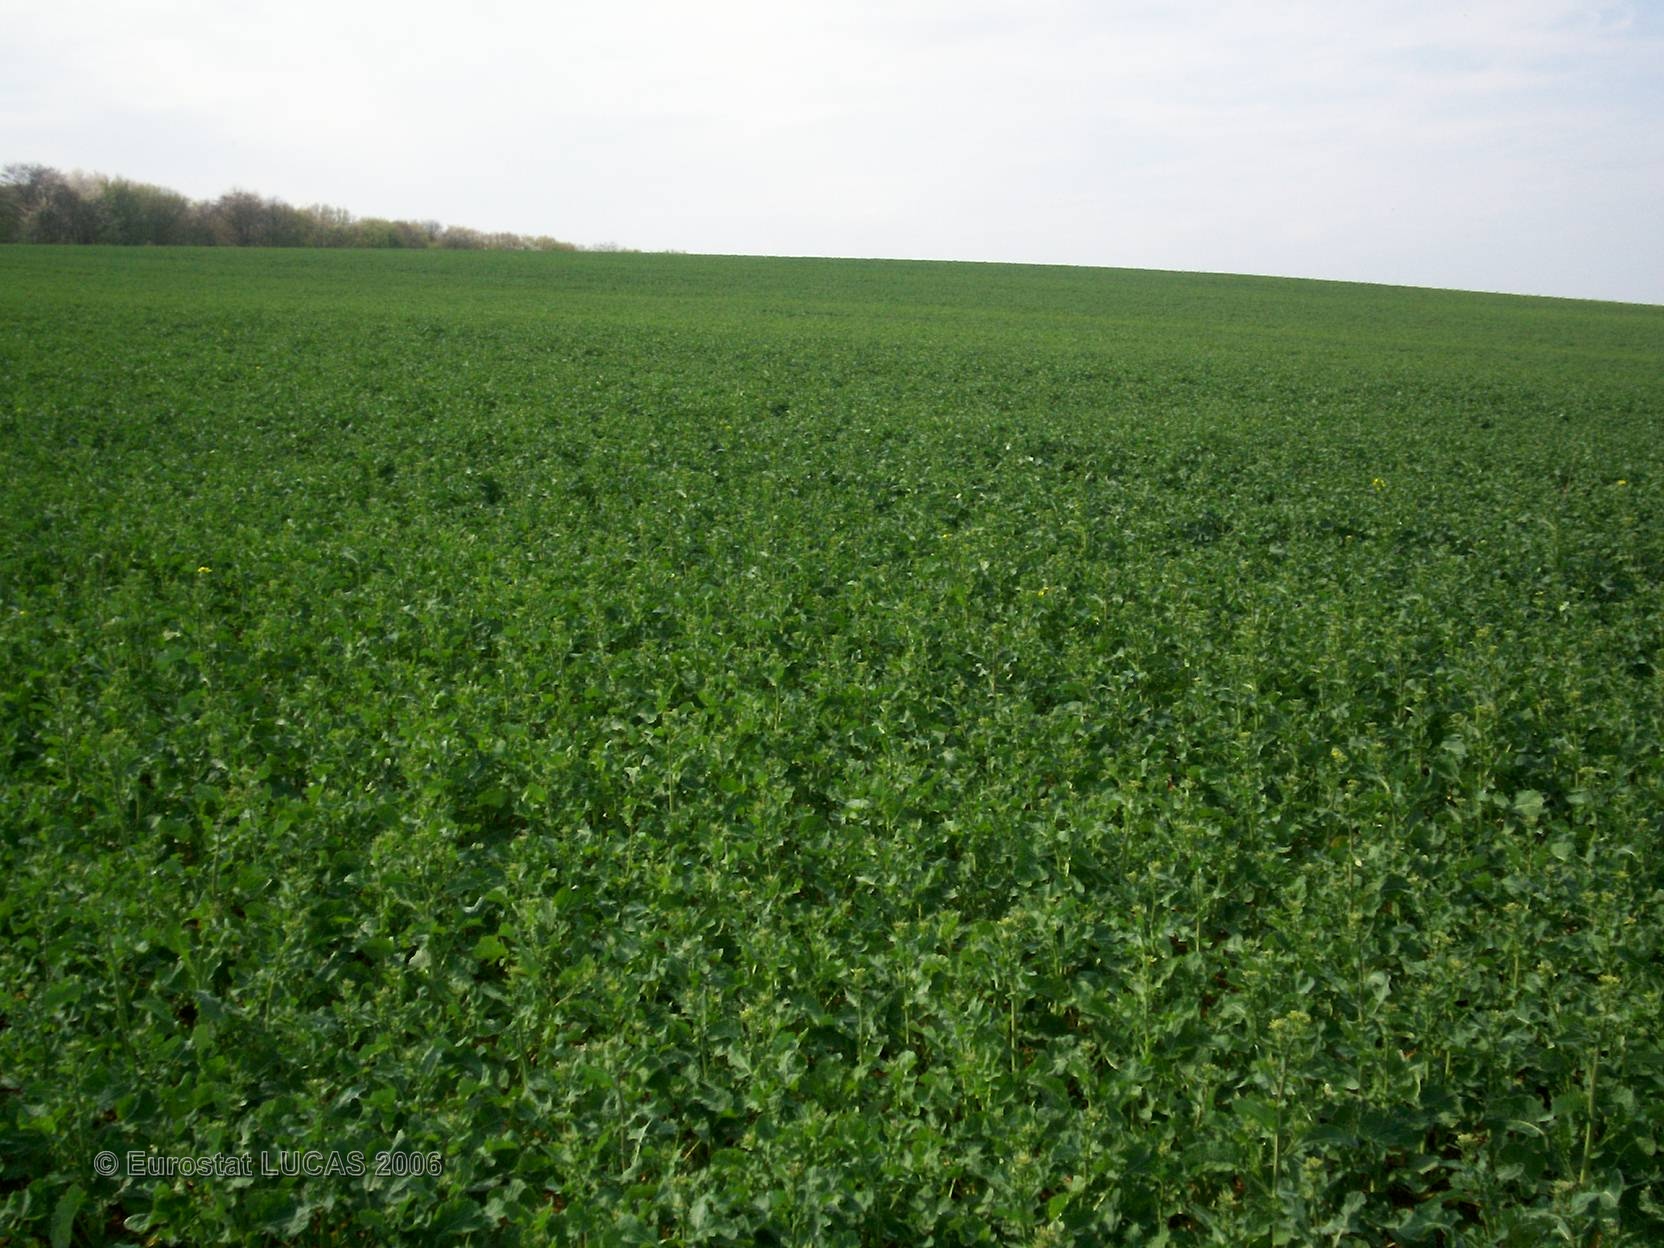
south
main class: Cropland
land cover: Rape and turnip rape
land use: Agriculture (excluding fallow land and kitchen gardens)
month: April
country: FR
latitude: 49.0673
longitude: 5.9343
